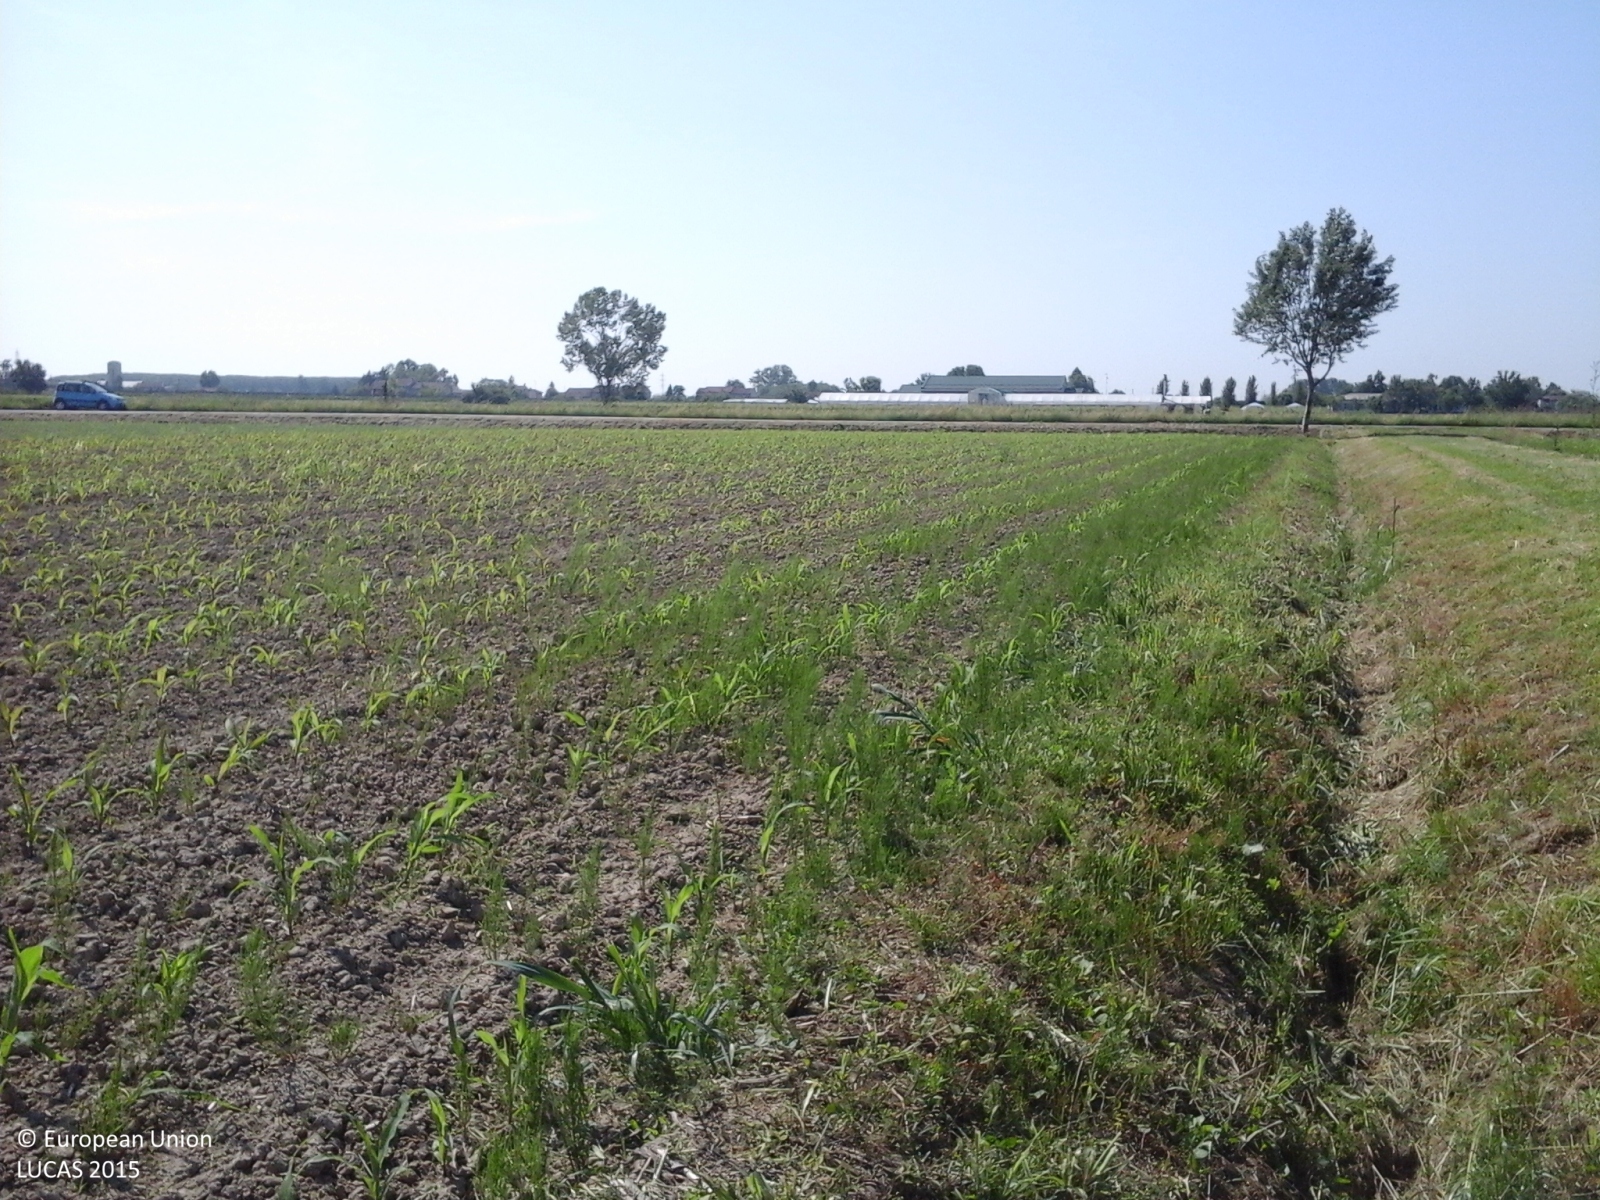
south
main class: Cropland
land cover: Maize
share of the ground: 10 - 25 %
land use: Agriculture (excluding fallow land and kitchen gardens)
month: May
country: IT
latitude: 44.9253
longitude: 10.6954
